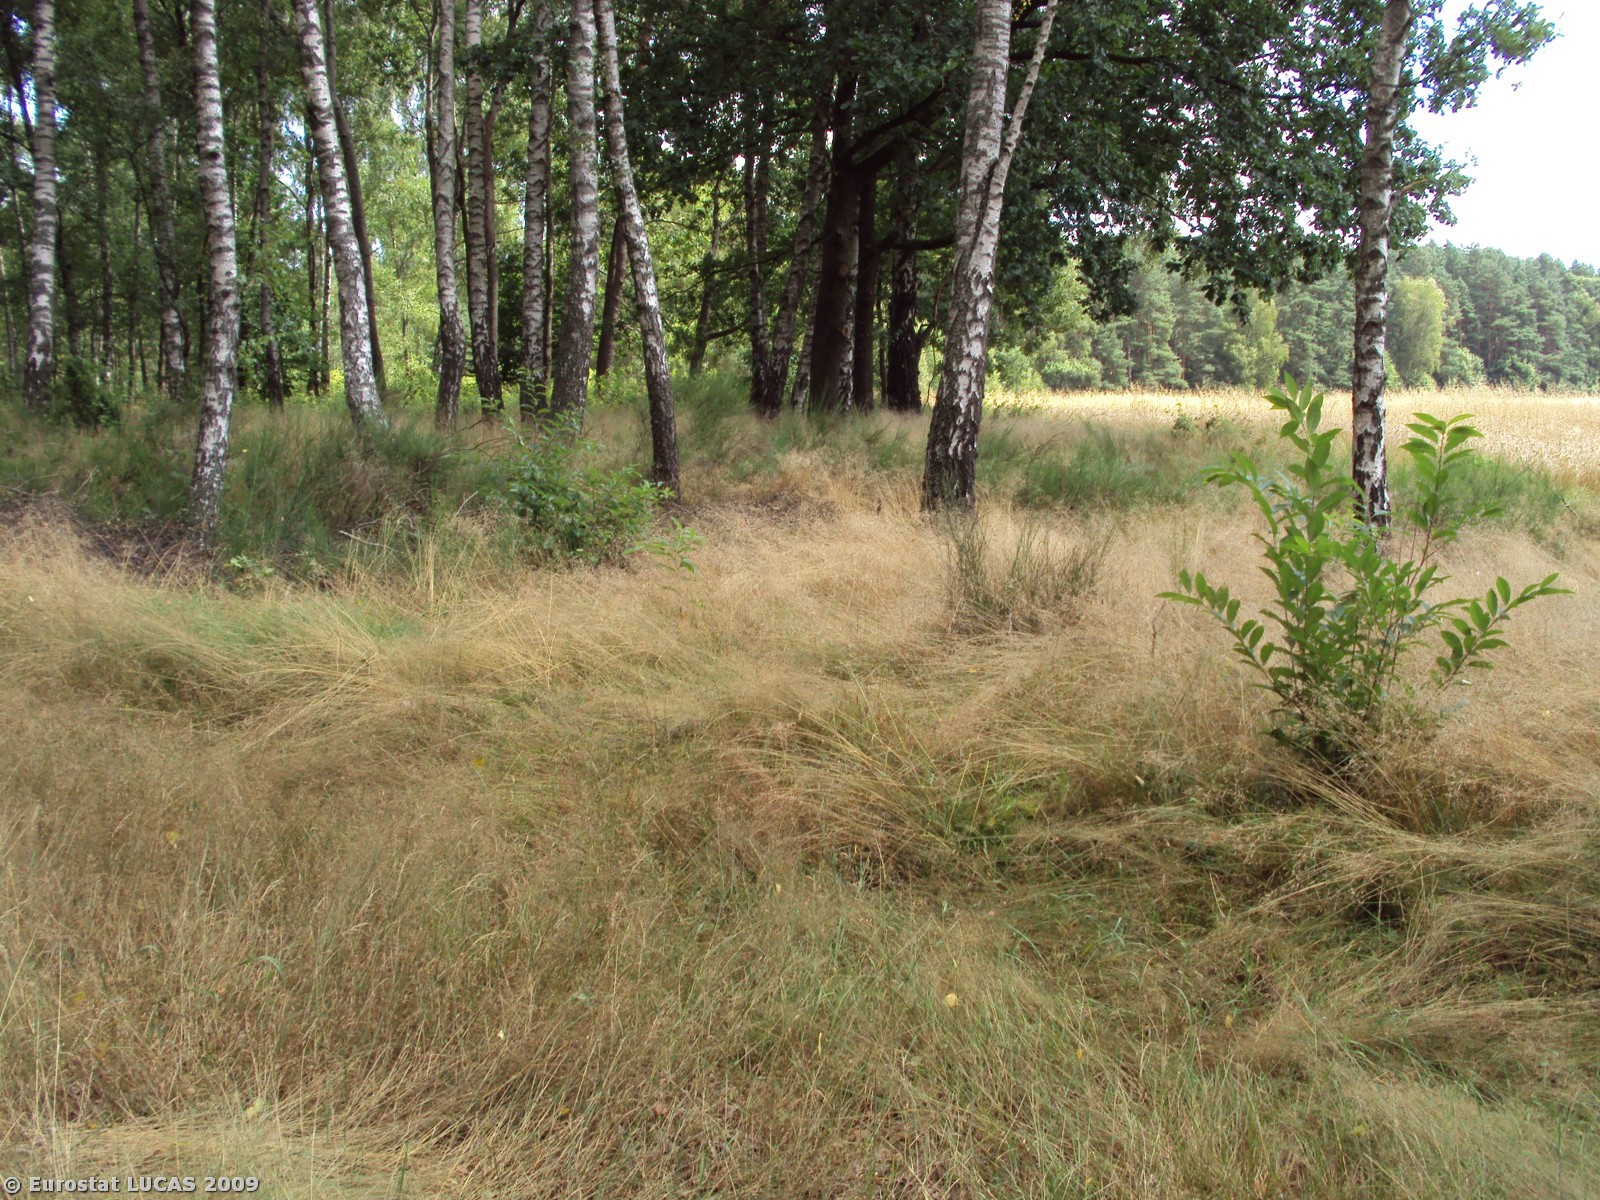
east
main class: Woodland
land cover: Broadleaved woodland
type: mesophytic deciduous forest
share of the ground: > 75 %
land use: Forestry
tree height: > 5 m
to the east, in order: Broadleaved woodland; Tracks; Mixed woodland
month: August
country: PL
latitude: 53.4881
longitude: 15.9881
